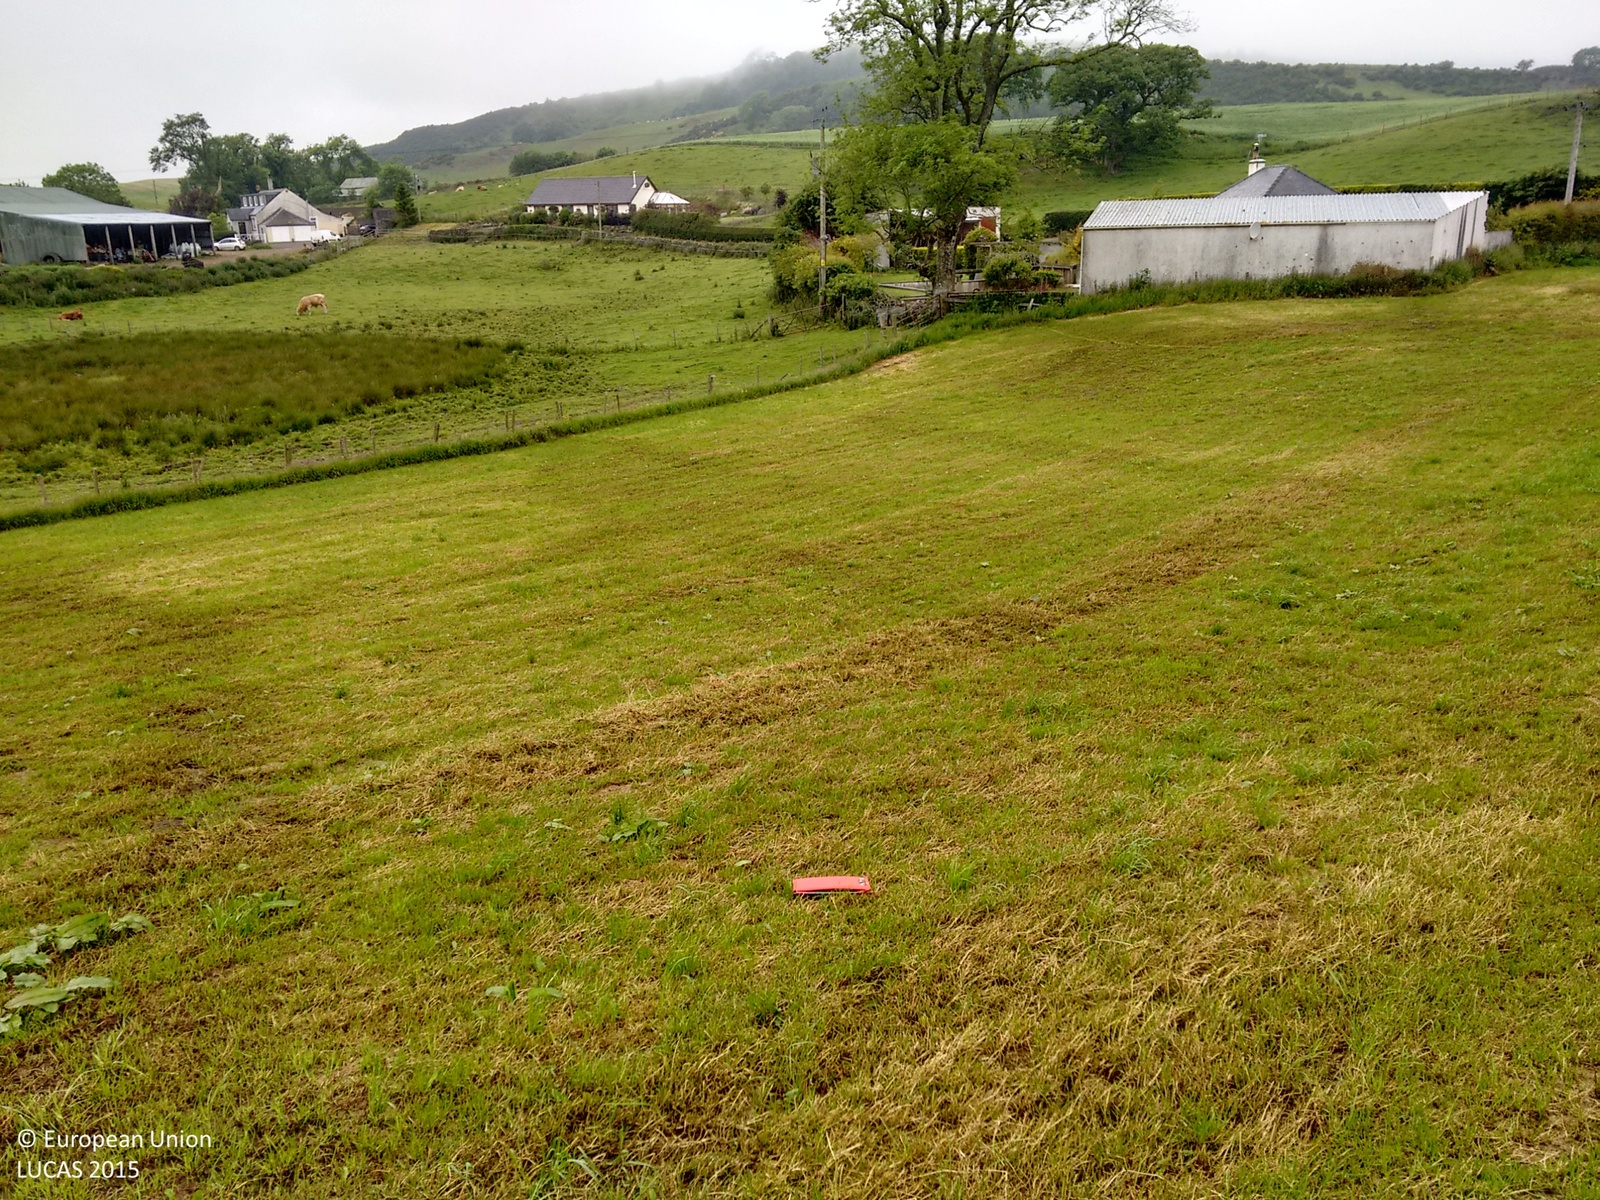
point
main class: Grassland
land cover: Grassland without tree/shrub cover
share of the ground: 25 - 50 %
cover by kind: herbaceous plants 50 %, unconsolidated bare surface 50 %
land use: Agriculture (excluding fallow land and kitchen gardens)
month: June
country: GB
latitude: 55.0656
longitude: -3.6915
